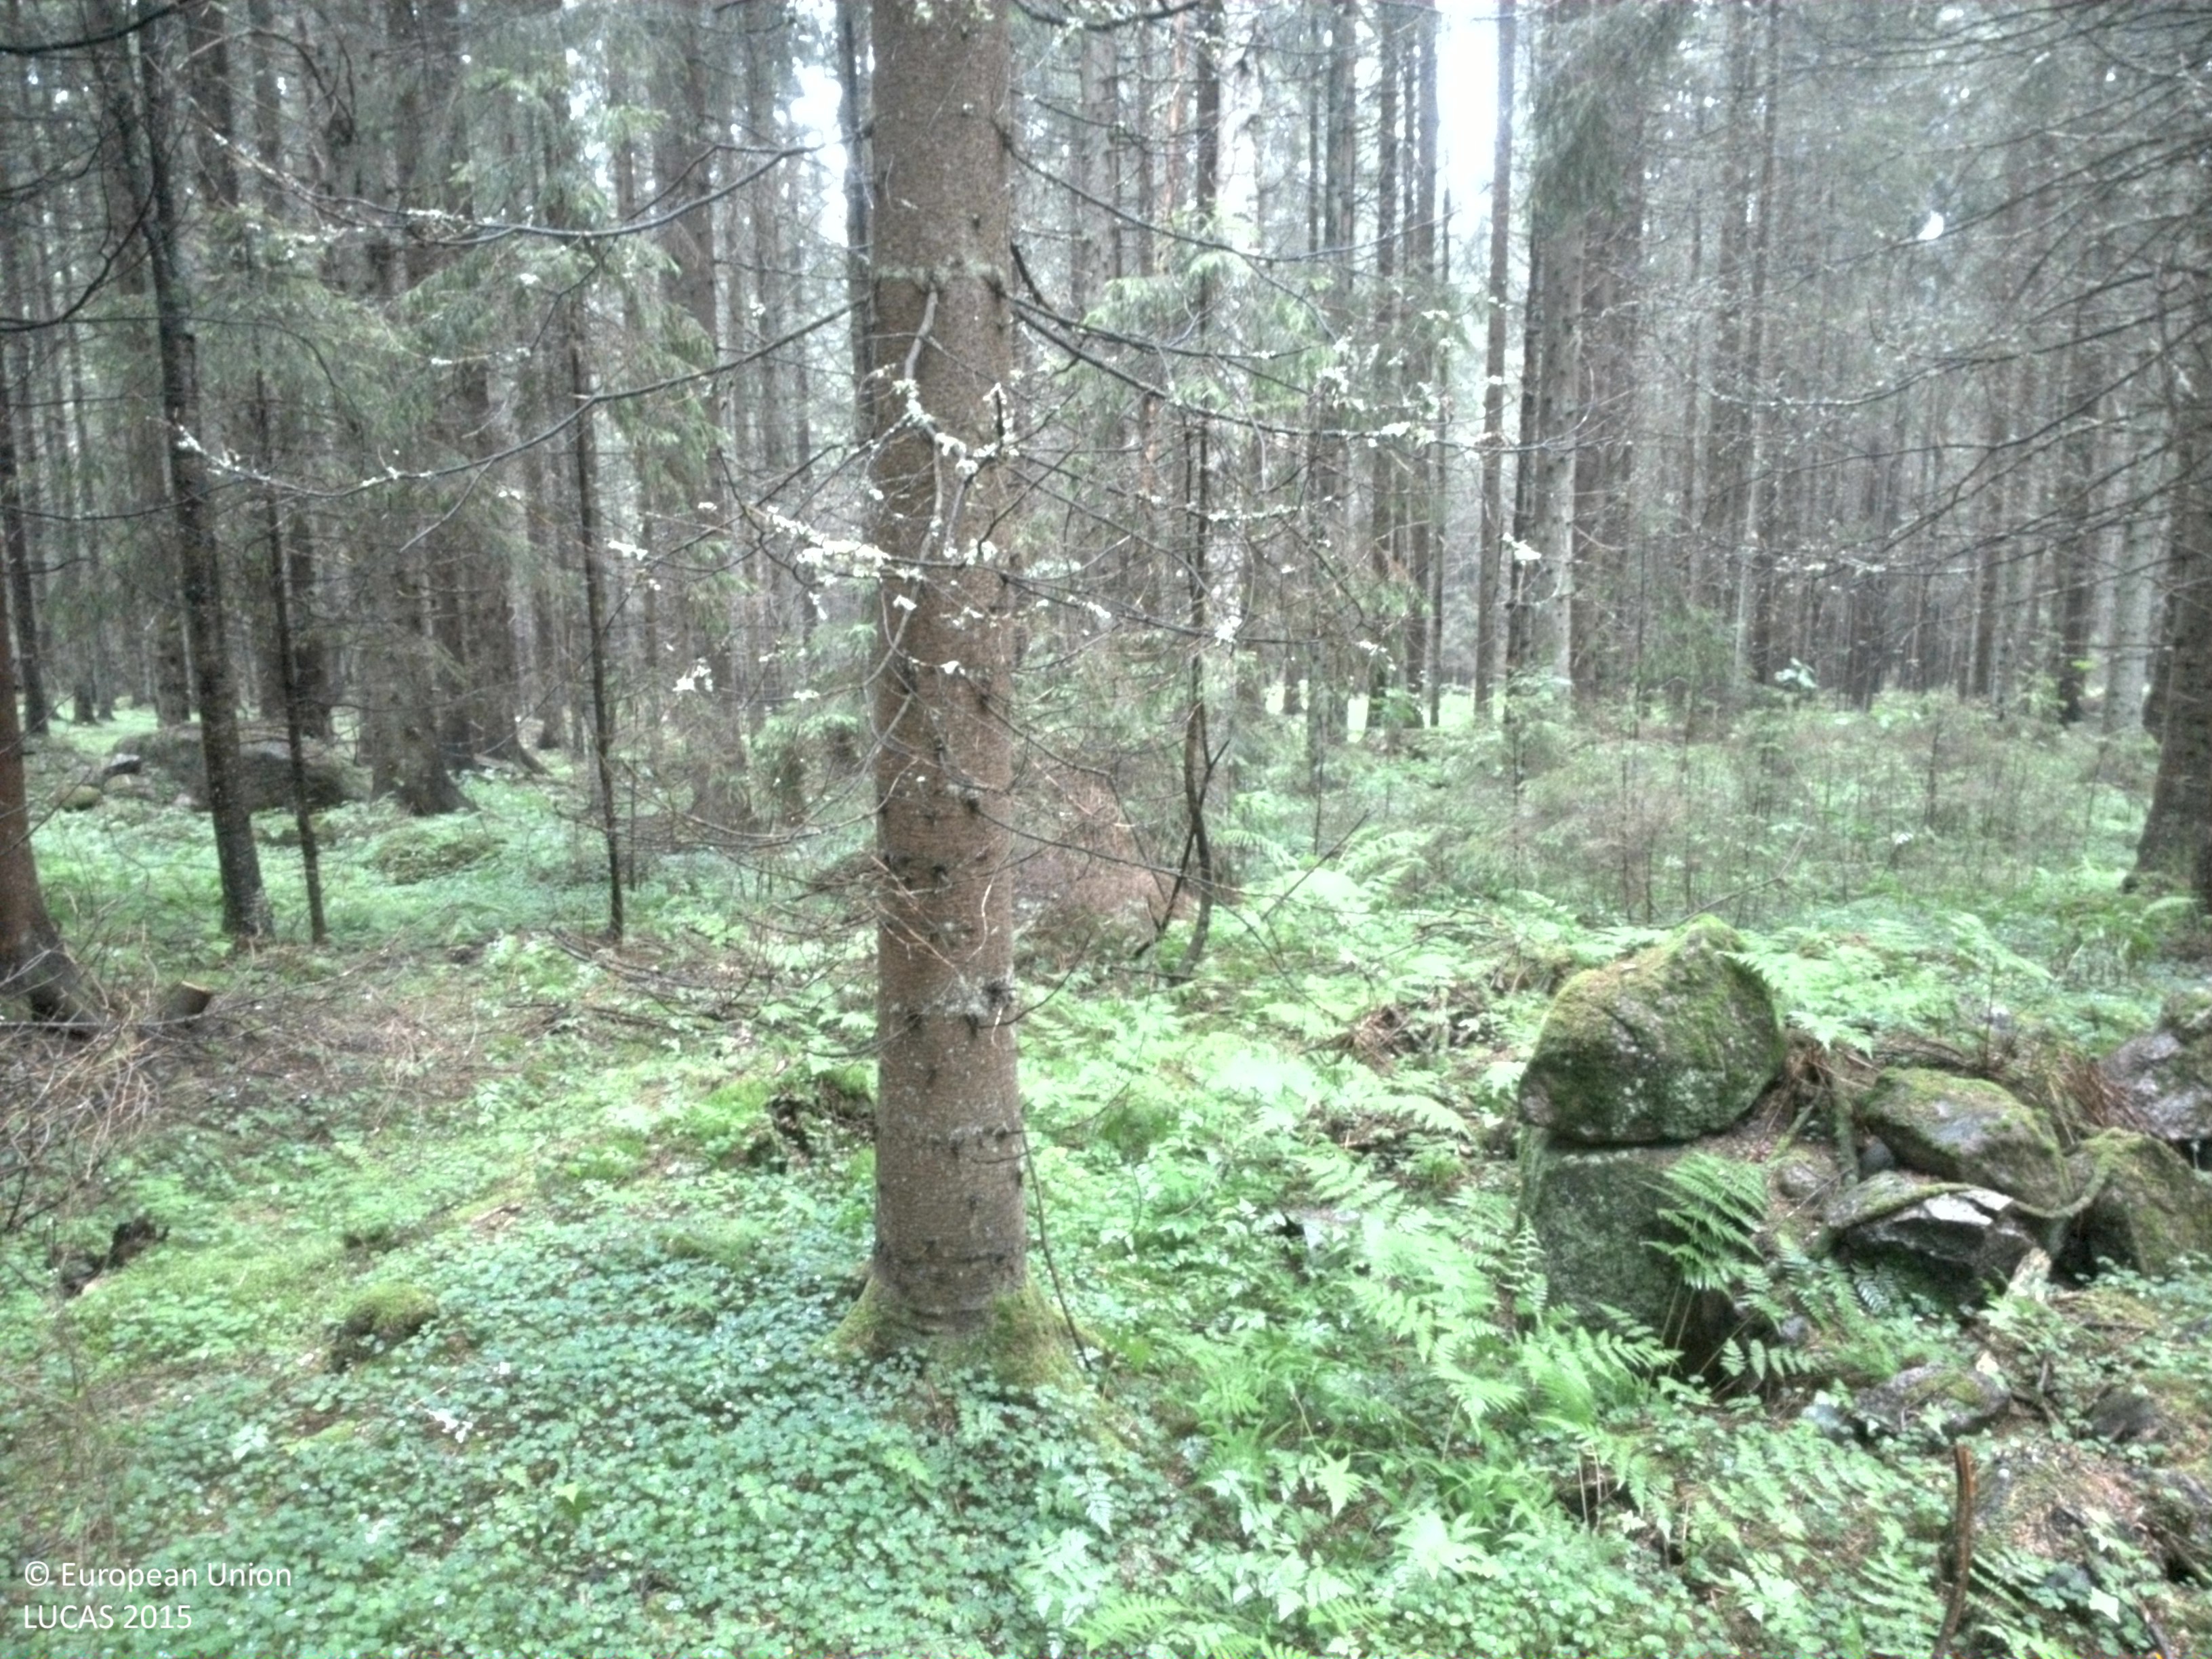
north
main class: Woodland
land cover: Spruce dominated coniferous woodland
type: boreal forest
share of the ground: > 75 %
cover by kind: coniferous forest trees 70 %, herbaceous plants 20 %, broadleaved forest trees 5 %, lichens and mosses 5 %
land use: Forestry
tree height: > 5 m
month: July
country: SE
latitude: 59.6876
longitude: 14.1295
